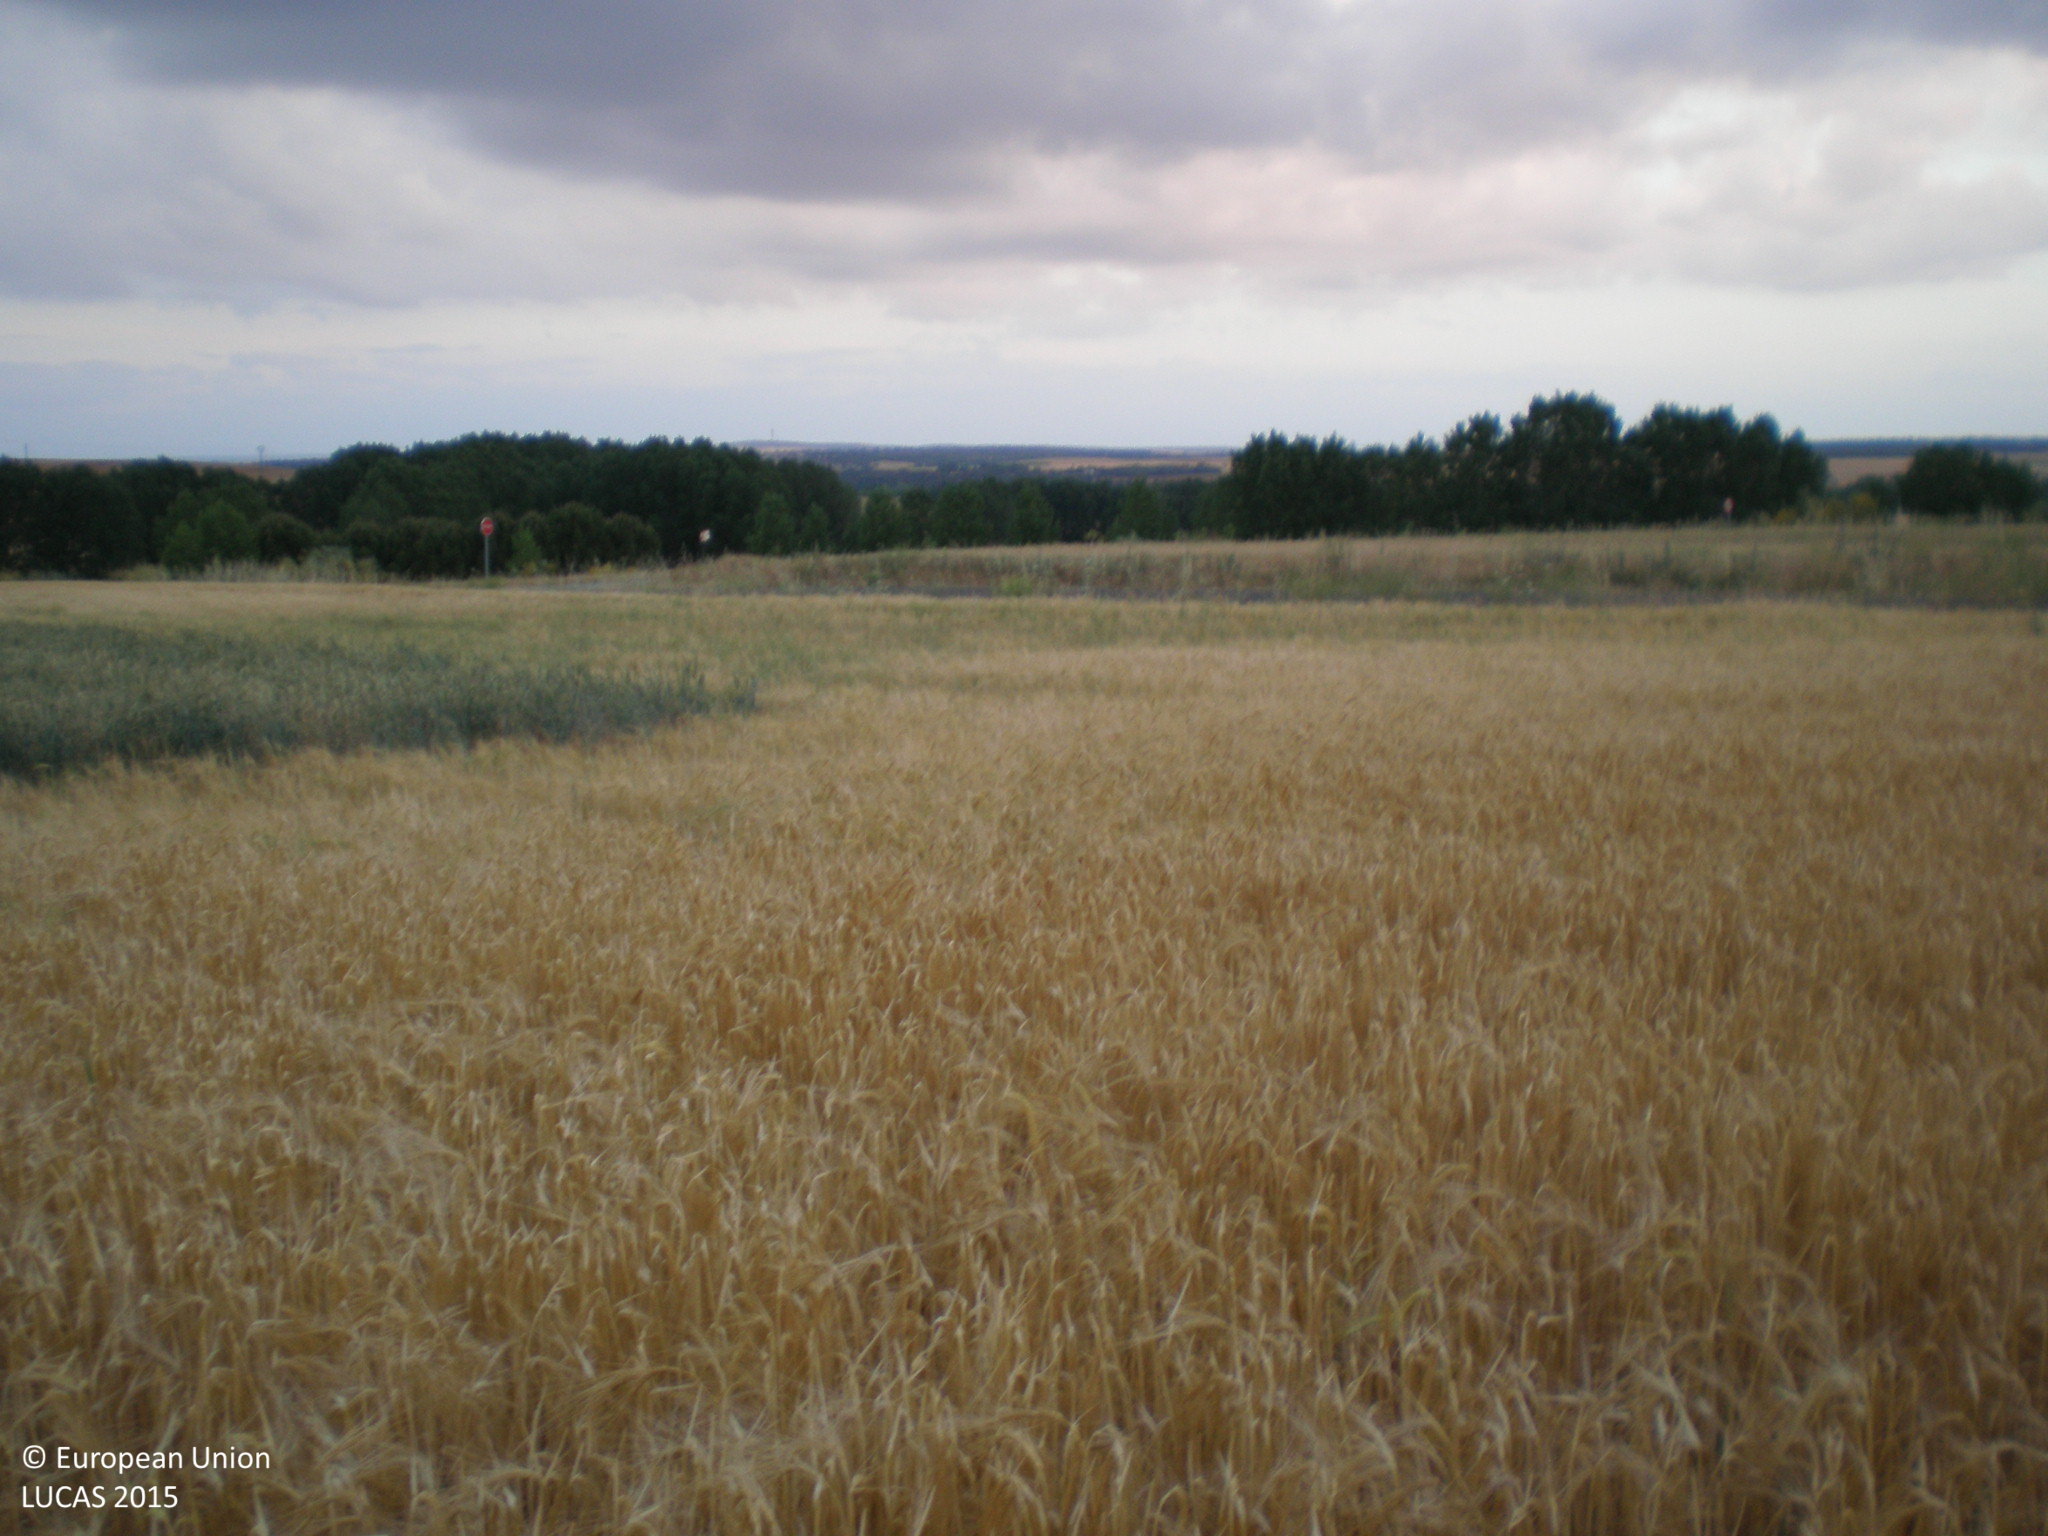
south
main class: Cropland
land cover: Barley
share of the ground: > 75 %
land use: Agriculture (excluding fallow land and kitchen gardens)
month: June
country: ES
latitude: 41.0596
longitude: -5.7759
